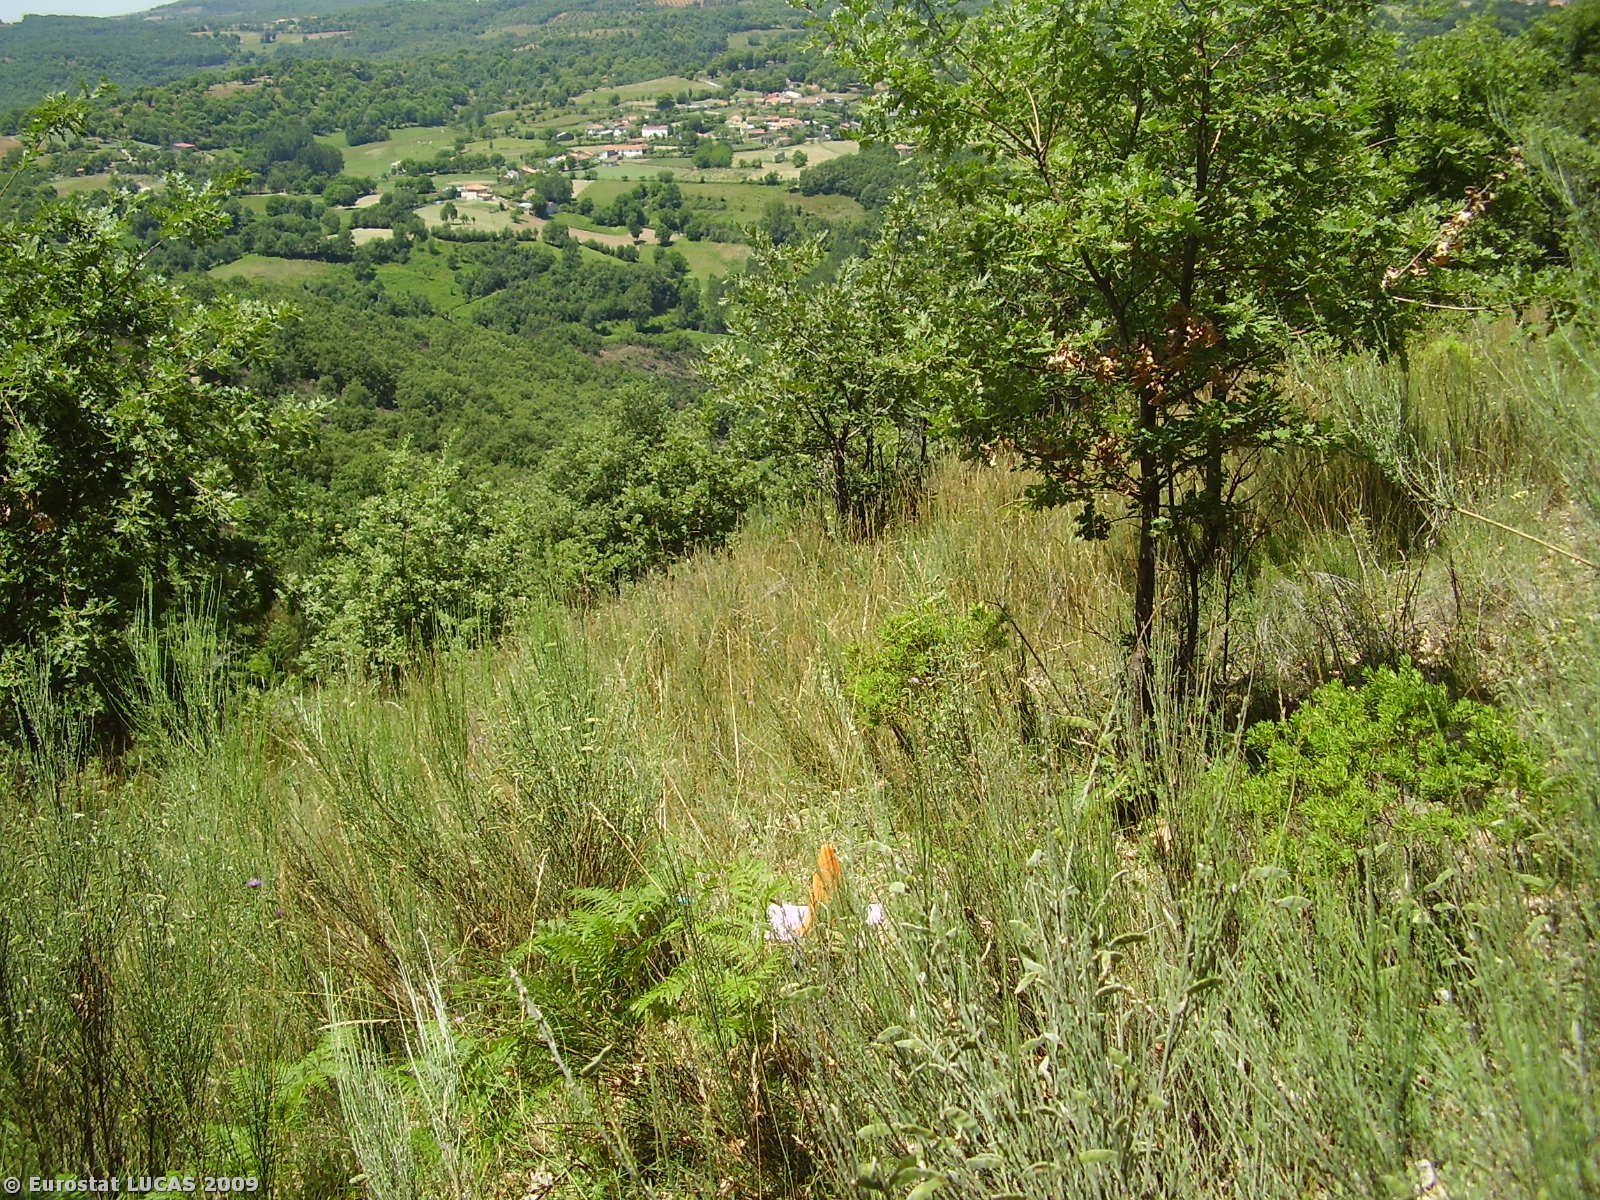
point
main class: Shrubland
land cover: Shrubland with sparse tree cover
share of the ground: 10 - 25 %
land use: Nature reserves
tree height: > 5 m
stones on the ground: 25 - 50 %
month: June
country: PT
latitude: 41.8622
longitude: -6.9234
